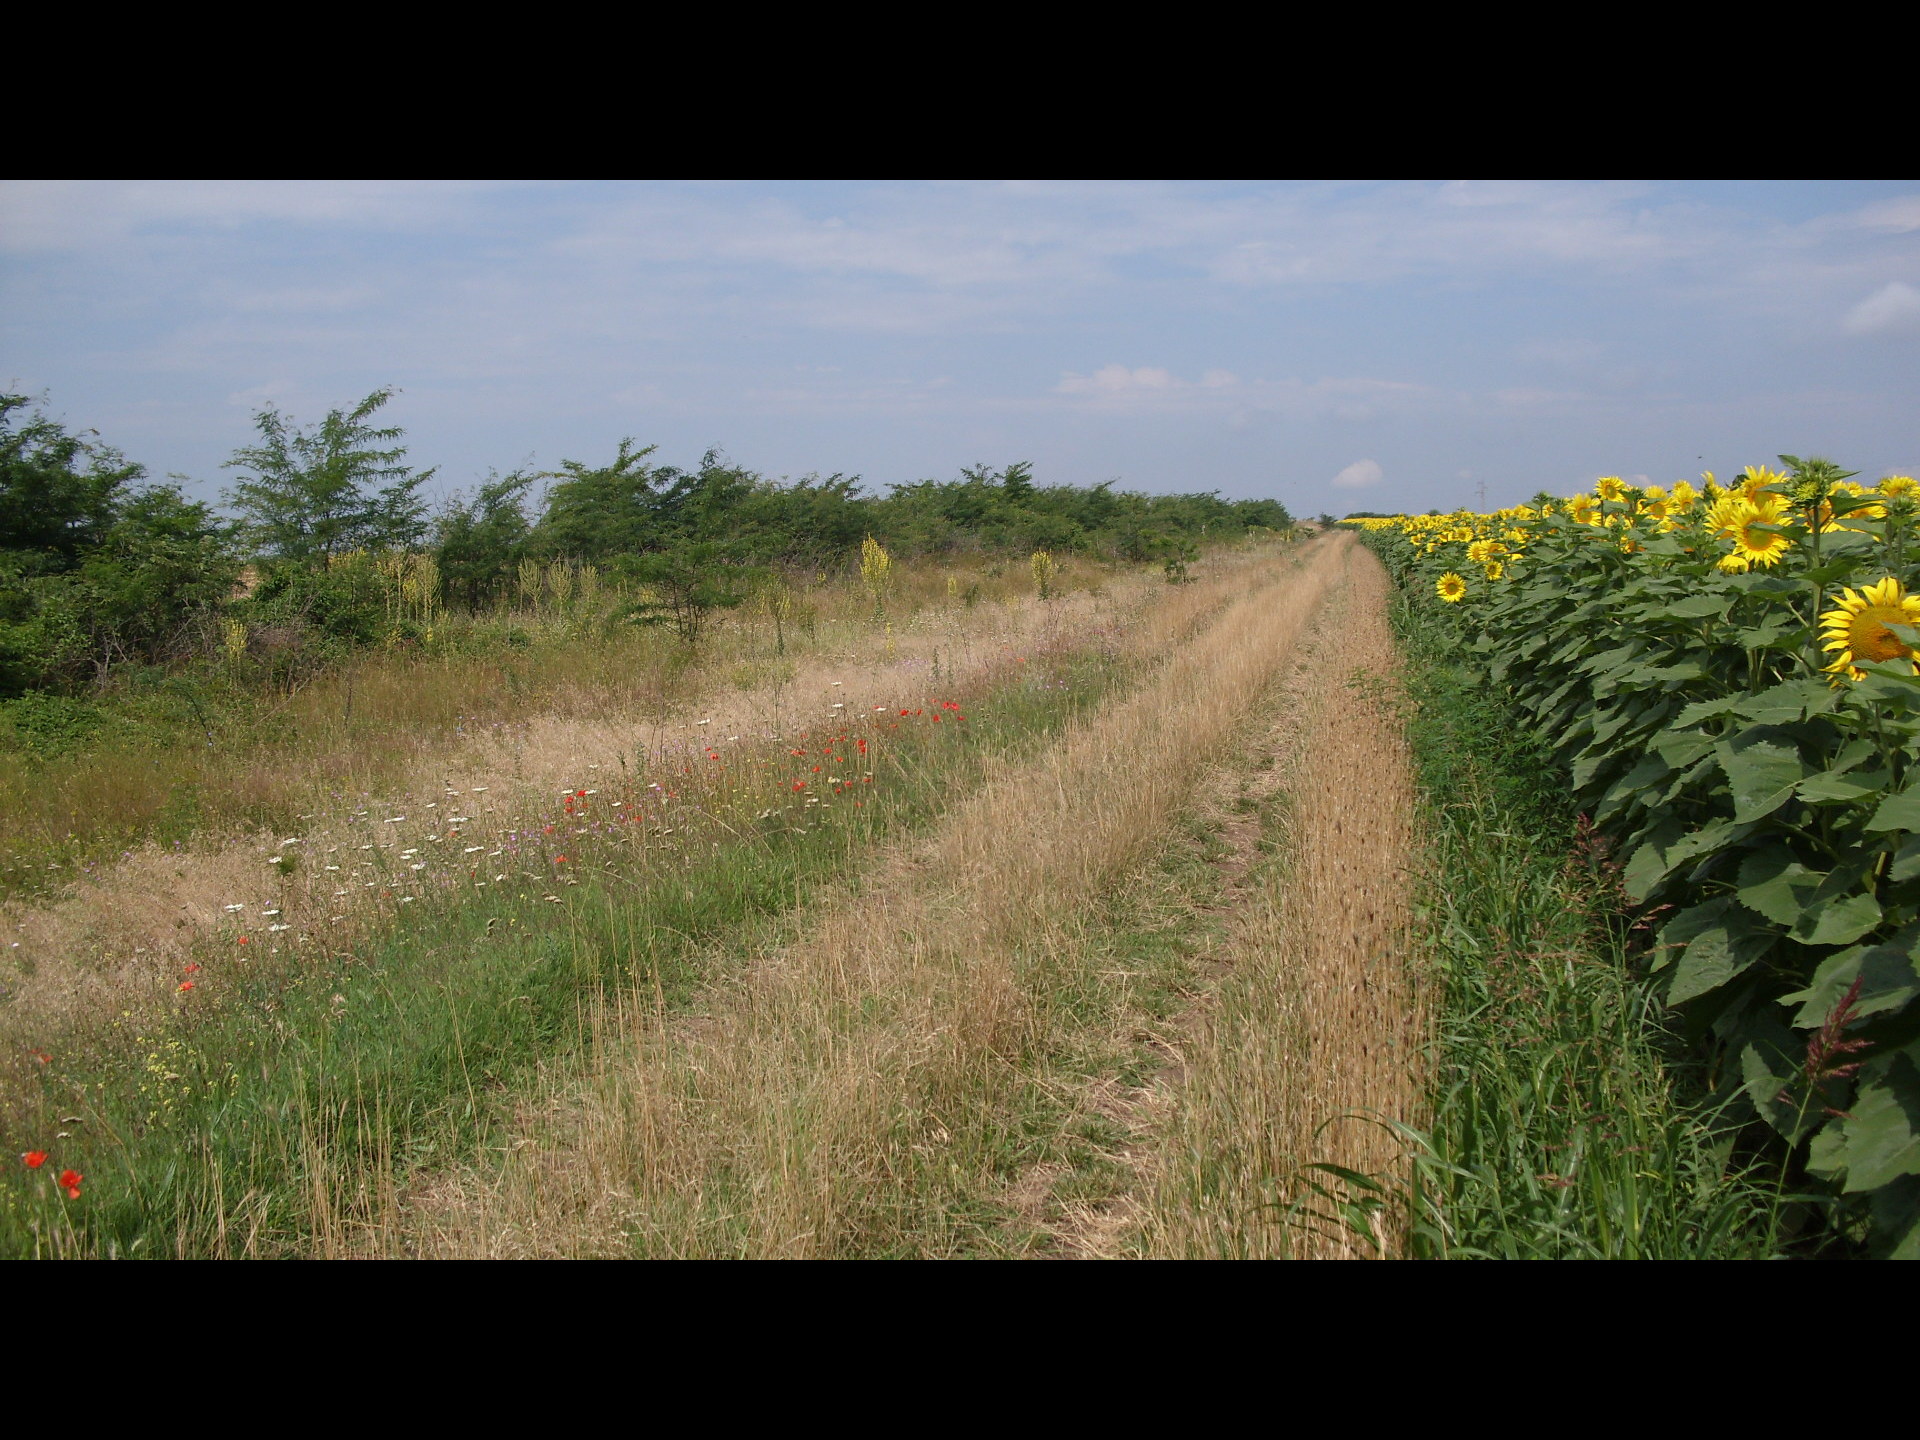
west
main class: Cropland
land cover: Sunflower
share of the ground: > 75 %
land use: Agriculture (excluding fallow land and kitchen gardens)
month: July
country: BG
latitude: 43.8124
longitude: 23.2082
